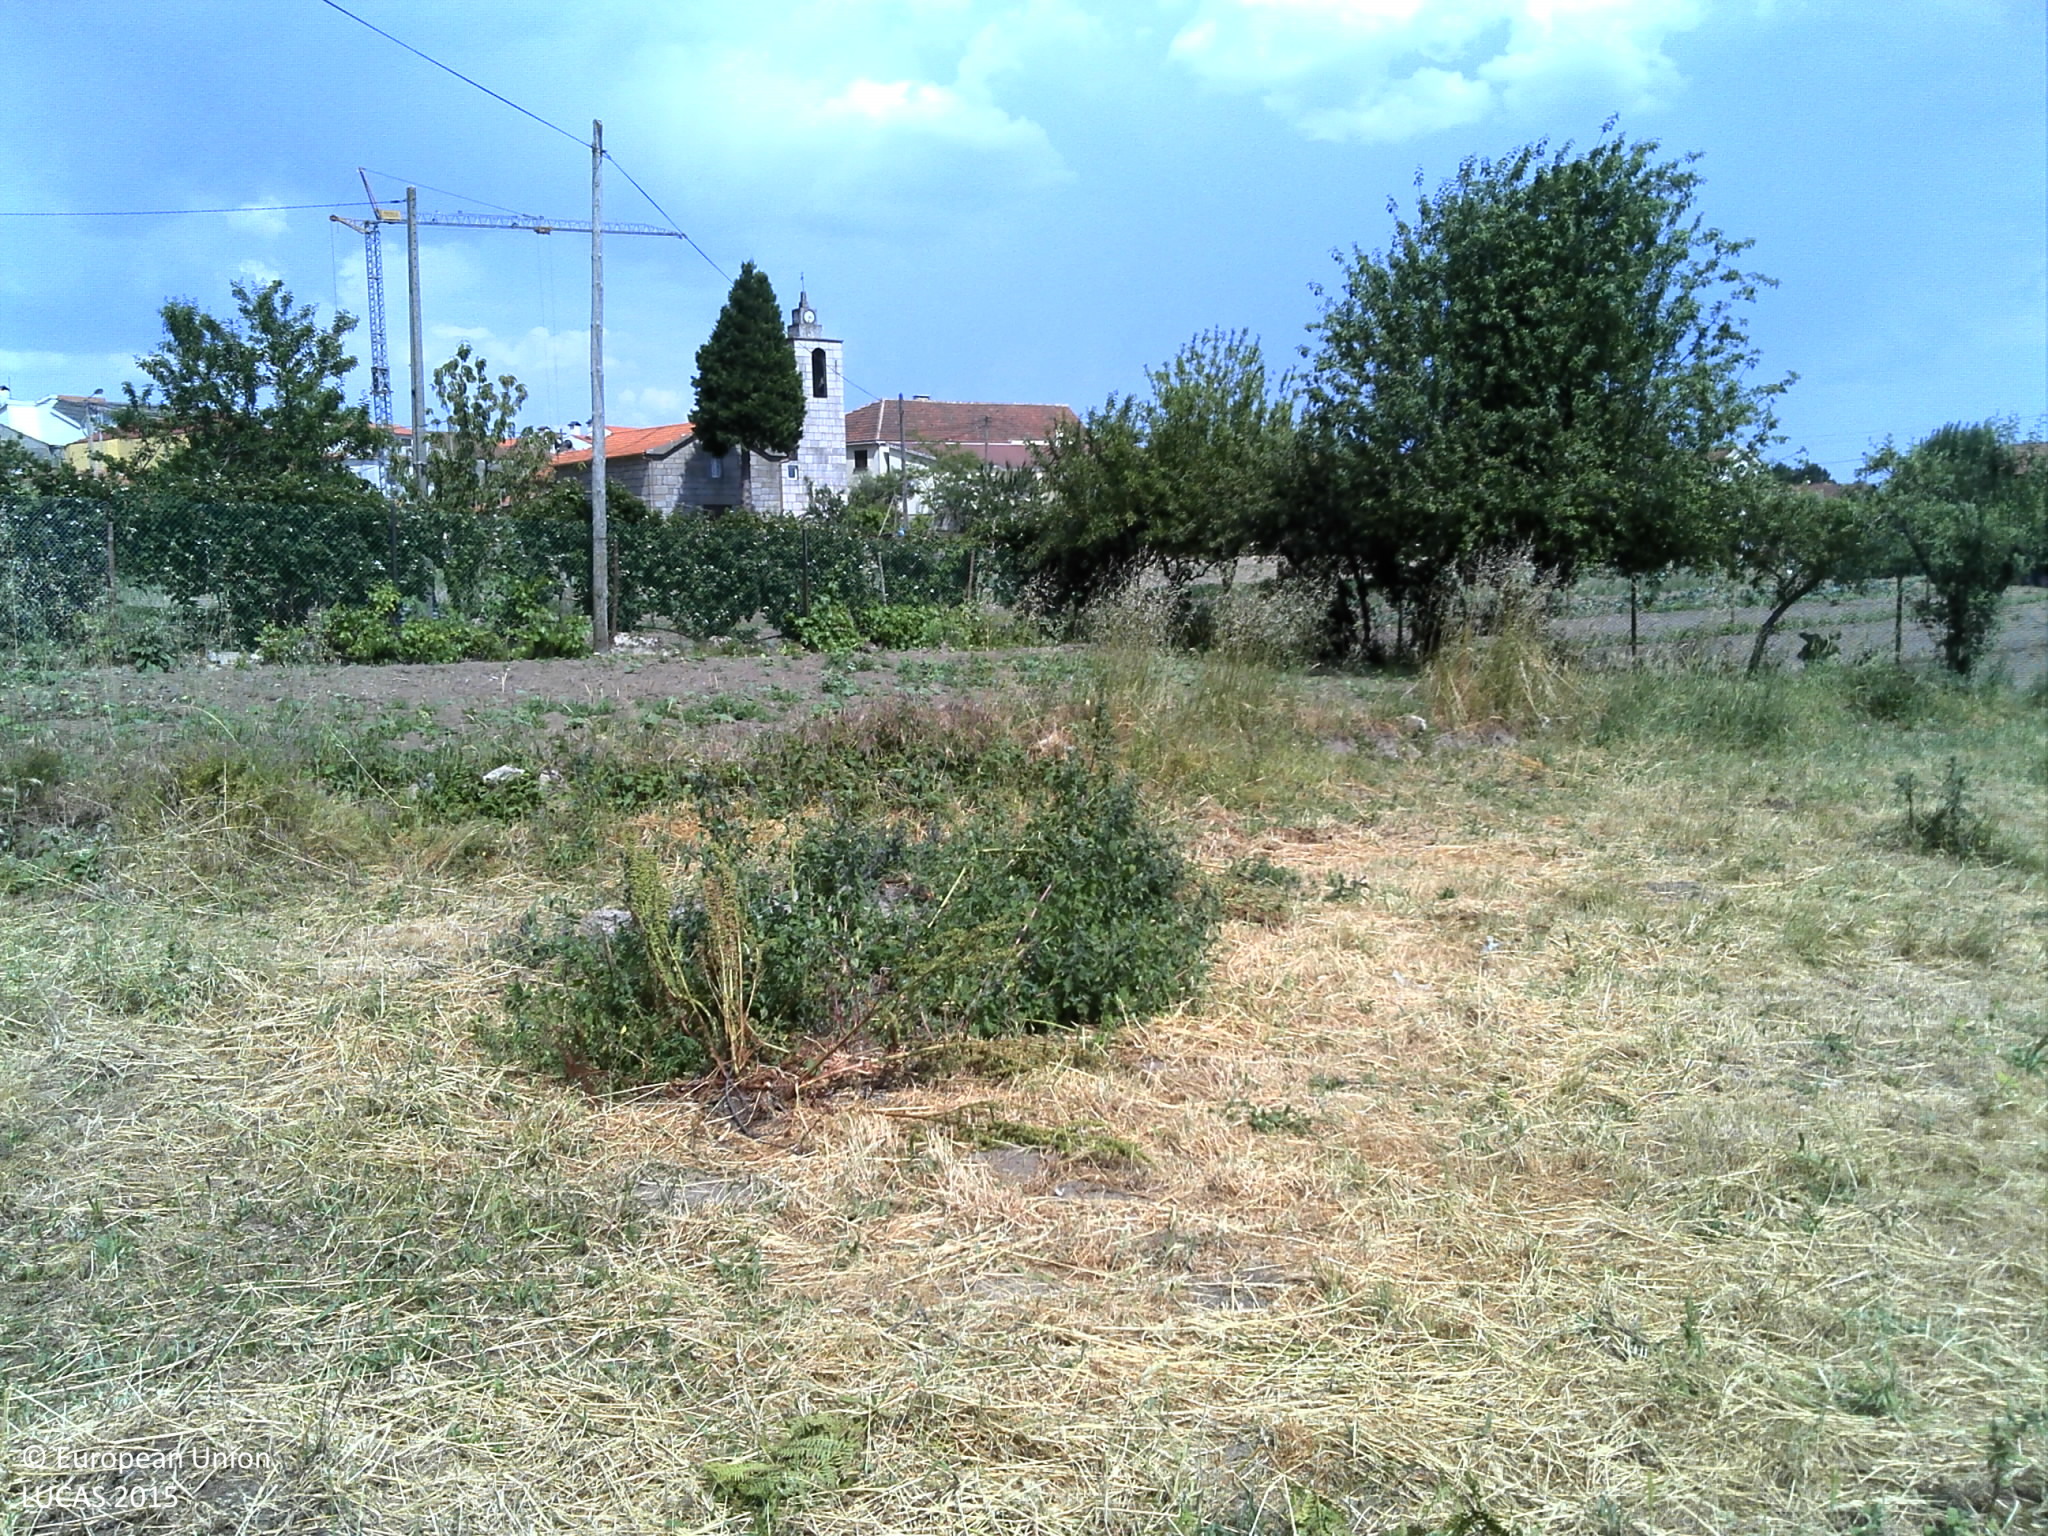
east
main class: Grassland
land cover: Grassland without tree/shrub cover
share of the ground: > 75 %
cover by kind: herbaceous plants 95 %, shrubs 5 %
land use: Agriculture (excluding fallow land and kitchen gardens)
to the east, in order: Grassland without tree/shrub cover; Dry stone walls; Potatoes; Other fresh vegetables; Fences; Other fruit trees and berries; Other root crops; Dry pulses; Potatoes; Maize; Electric lines; Maize; Artificial constructions in urban areas
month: June
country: PT
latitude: 41.3323
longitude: -7.6329
